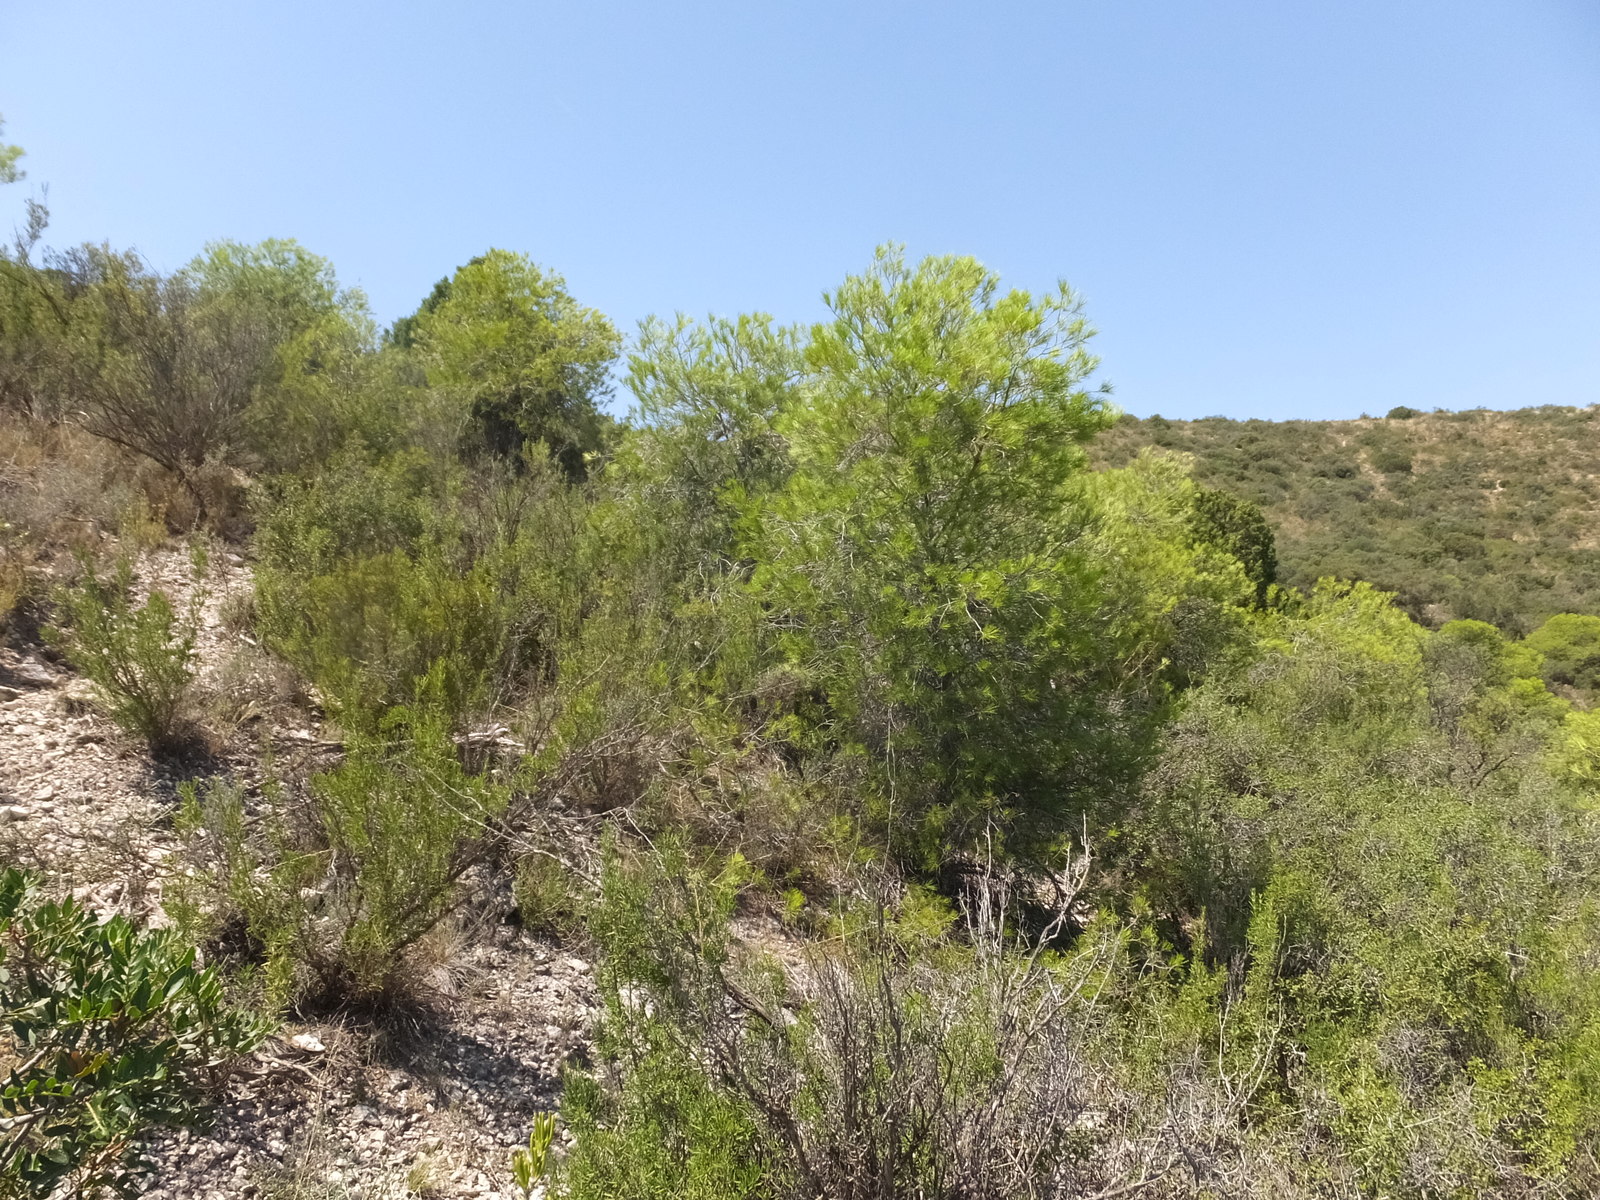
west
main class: Shrubland
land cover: Shrubland with sparse tree cover
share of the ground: > 75 %
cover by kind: shrubs 70 %, herbaceous plants 25 %, coniferous forest trees 5 %
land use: Semi-natural and natural areas not in use
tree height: < 5 m
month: August
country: ES
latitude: 41.4392
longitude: 0.0887
